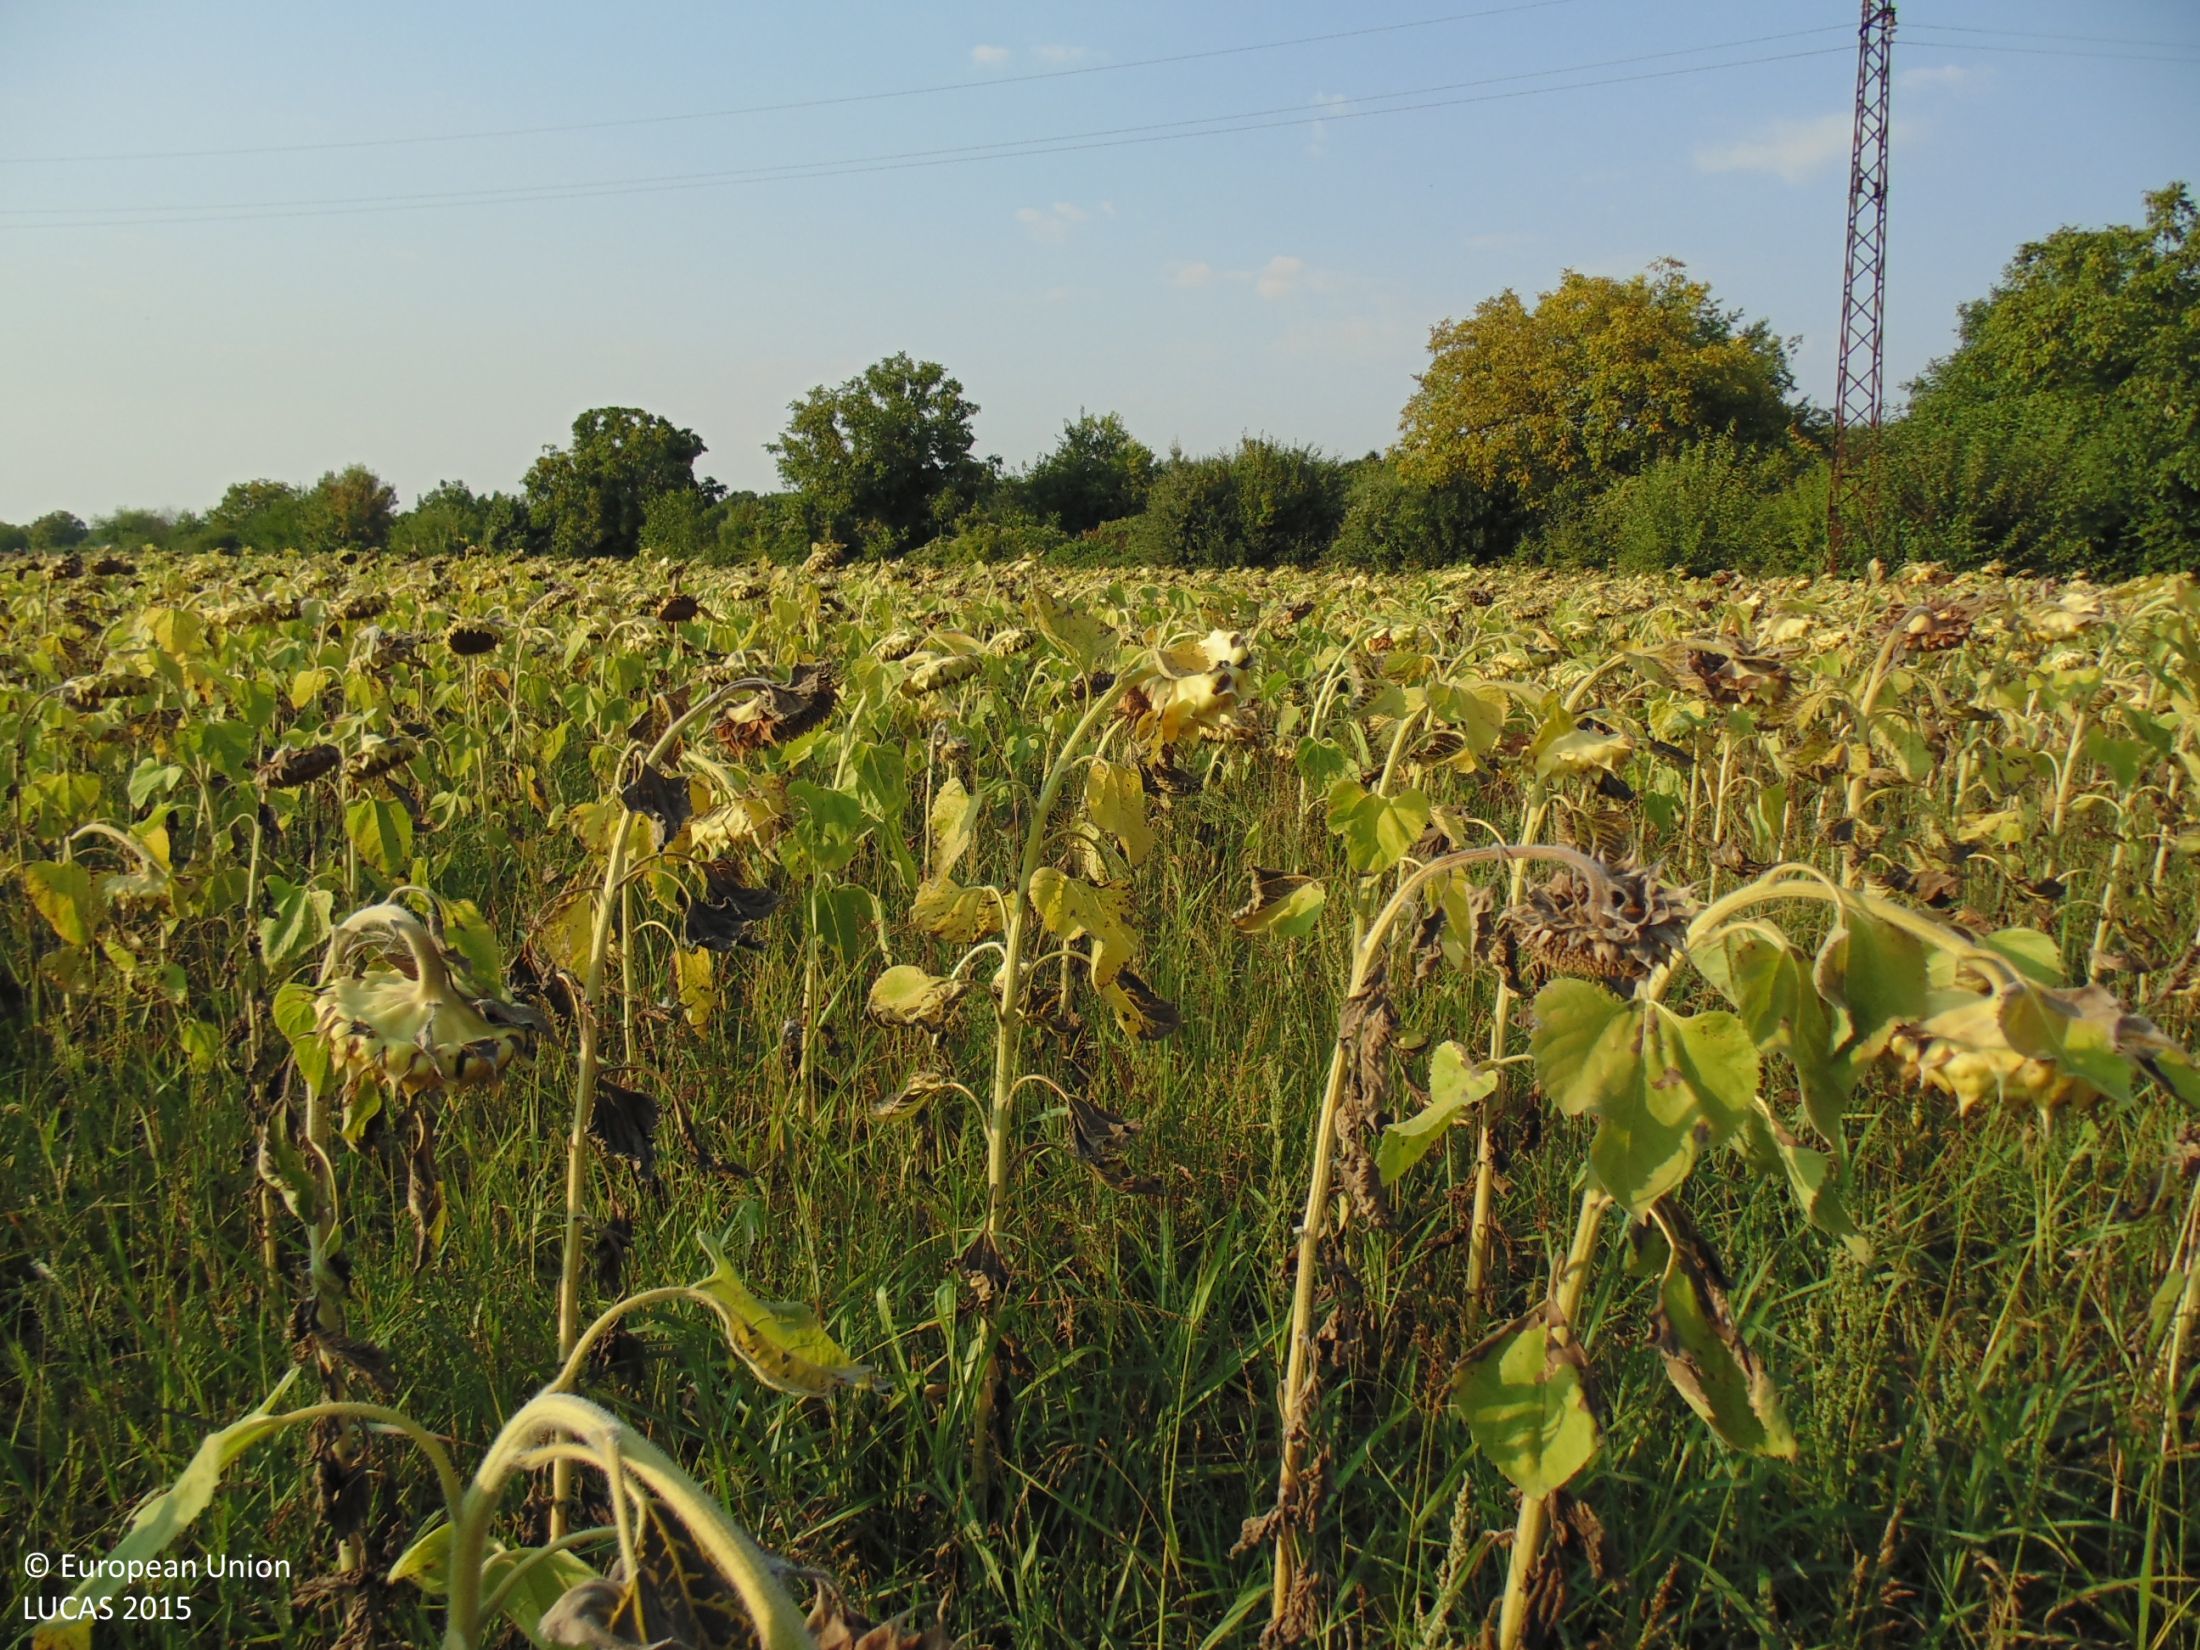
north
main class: Cropland
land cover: Sunflower
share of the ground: > 75 %
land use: Agriculture (excluding fallow land and kitchen gardens)
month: August
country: BG
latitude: 43.8538
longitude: 27.3358
